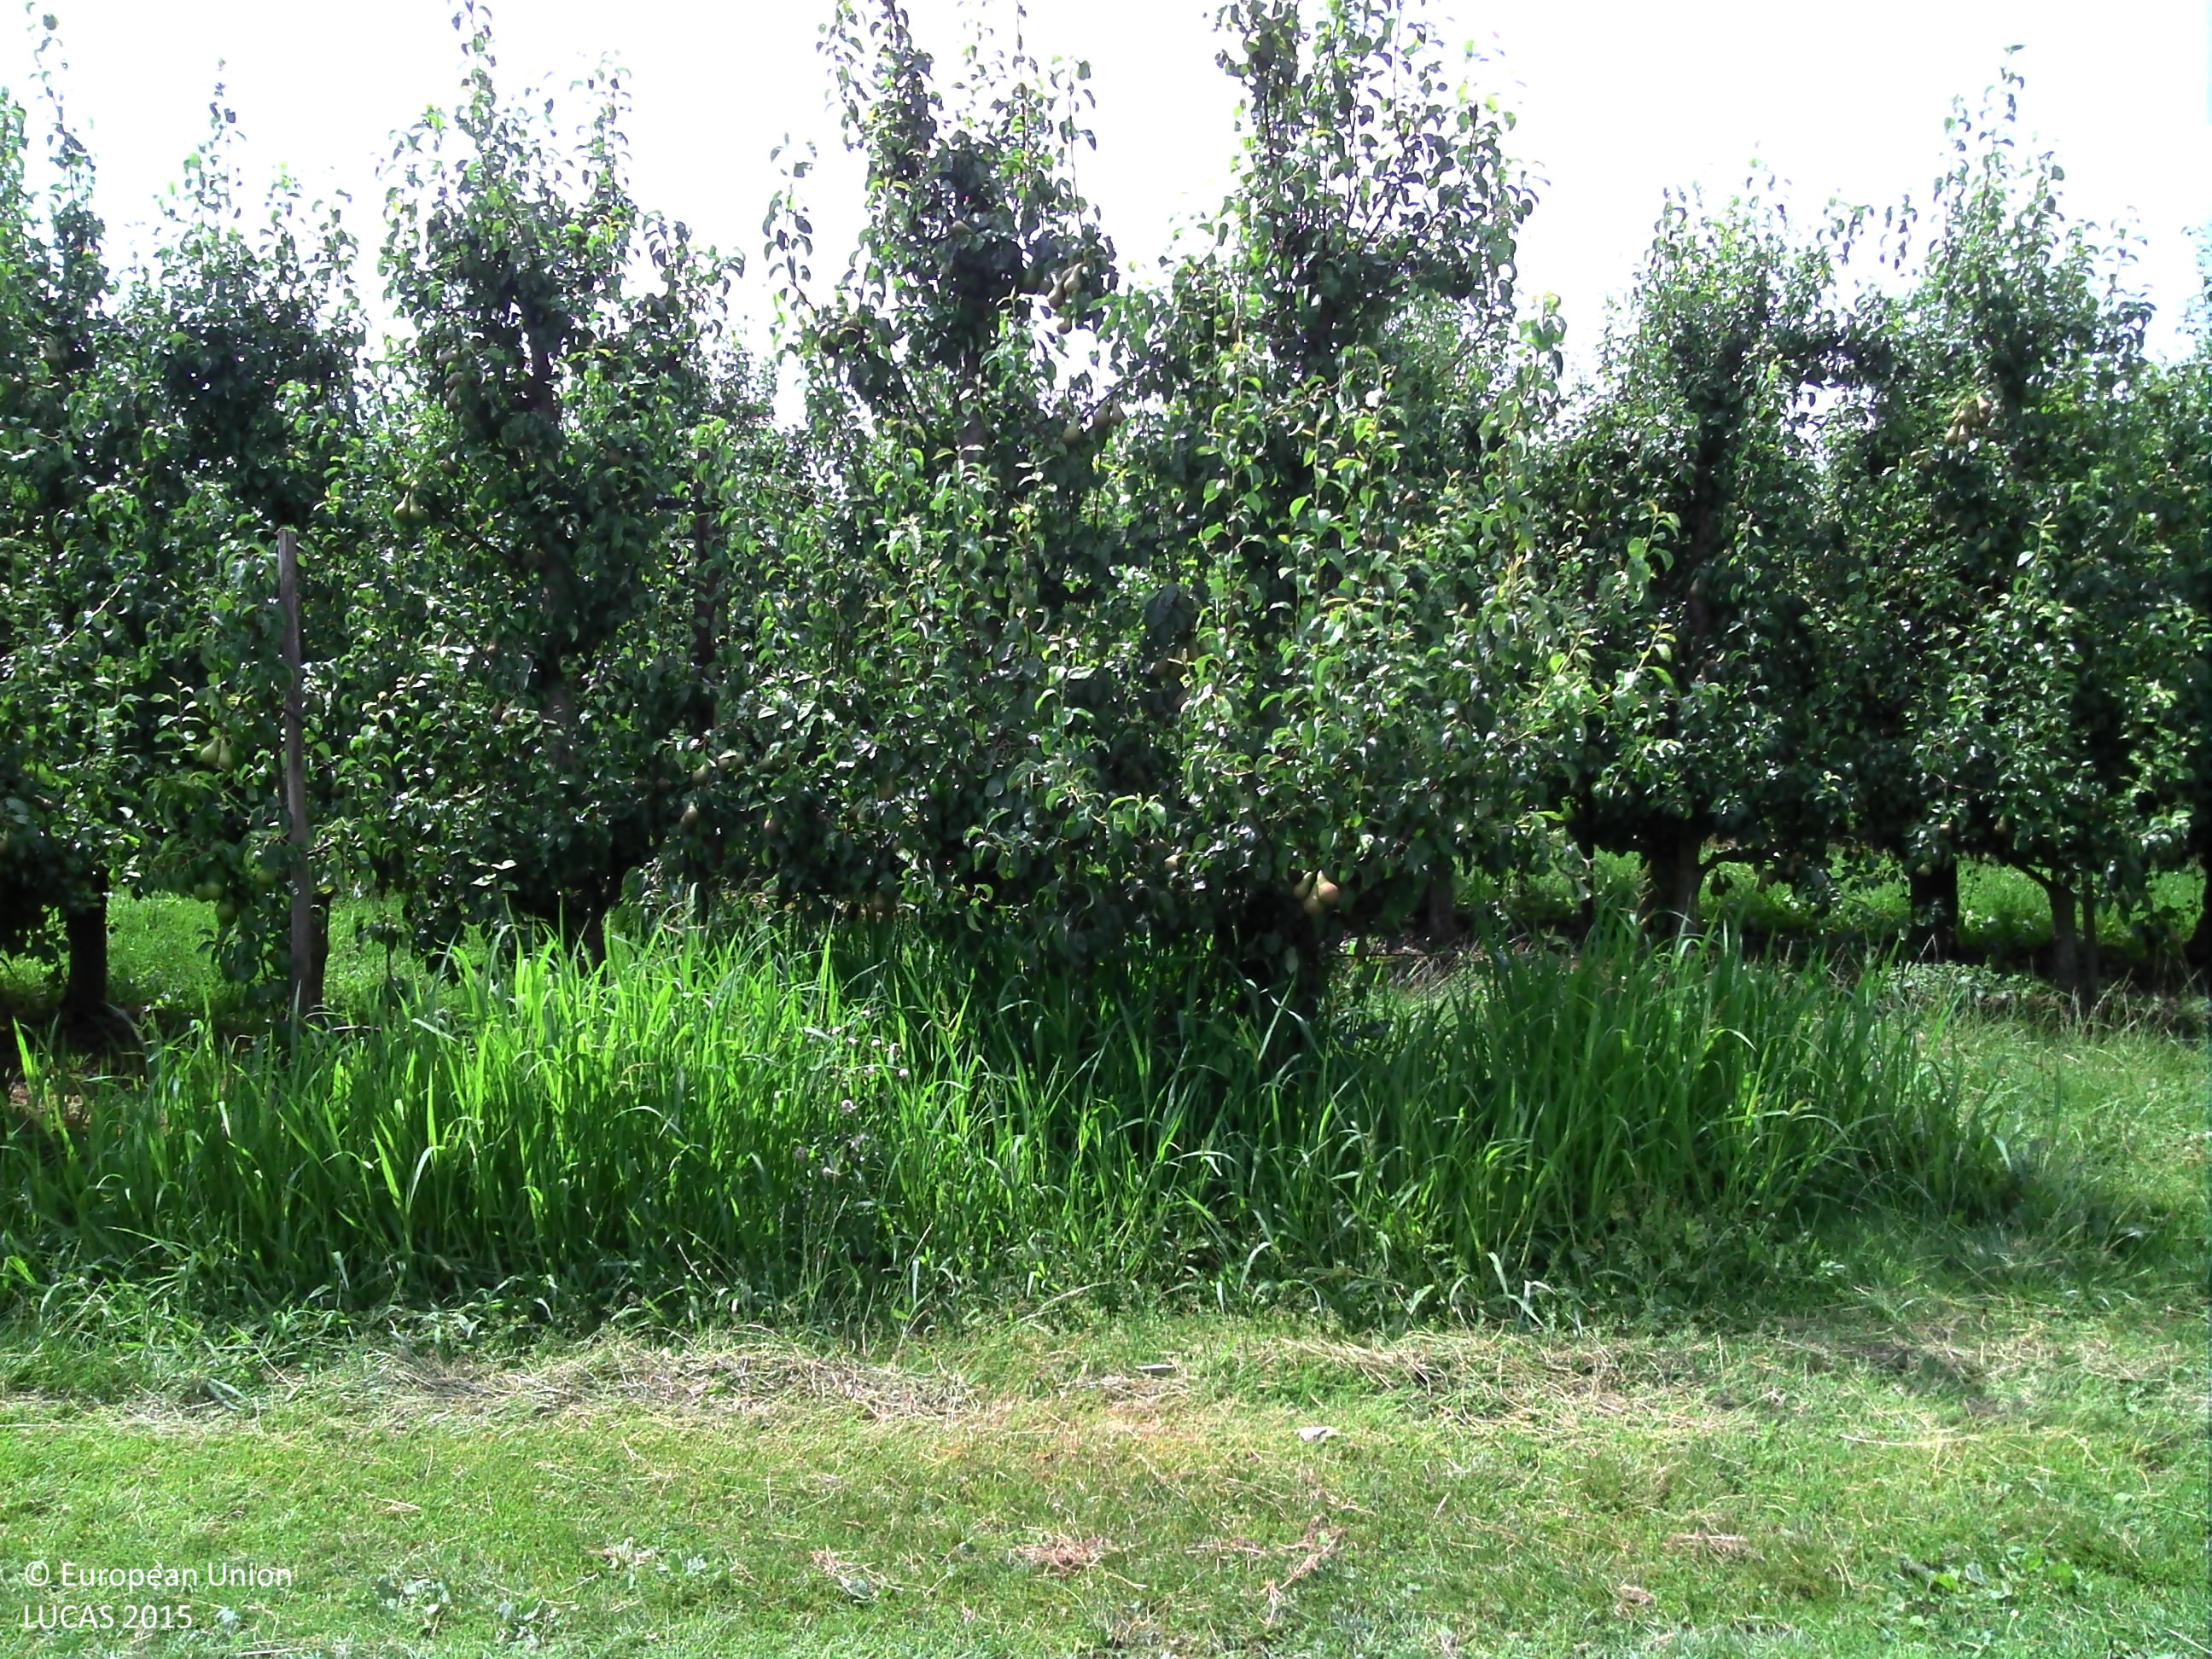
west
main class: Cropland
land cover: Maize
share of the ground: > 75 %
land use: Agriculture (excluding fallow land and kitchen gardens)
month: July
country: BE
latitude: 50.7167
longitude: 5.7354
